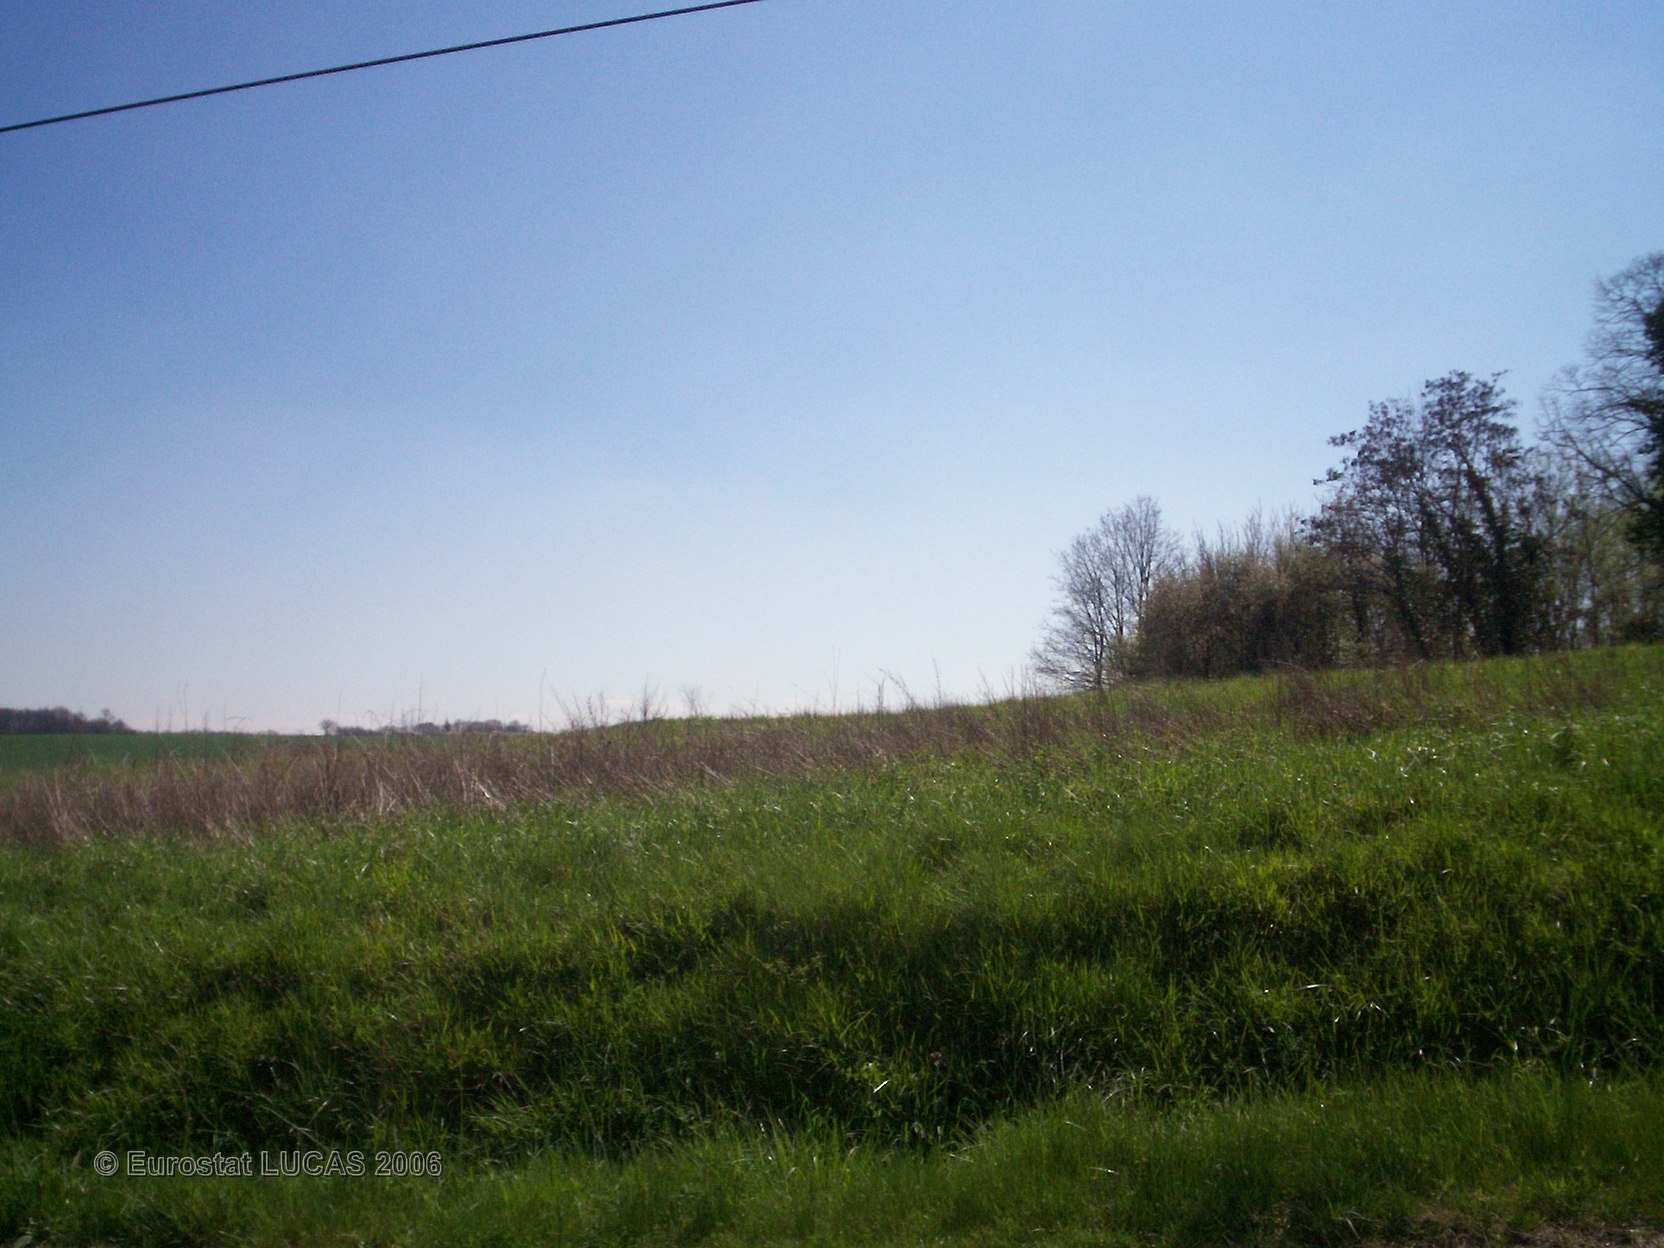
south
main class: Grassland
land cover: Grassland without tree/shrub cover
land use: Agriculture (excluding fallow land and kitchen gardens)
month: April
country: FR
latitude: 44.0250
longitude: 0.9274
